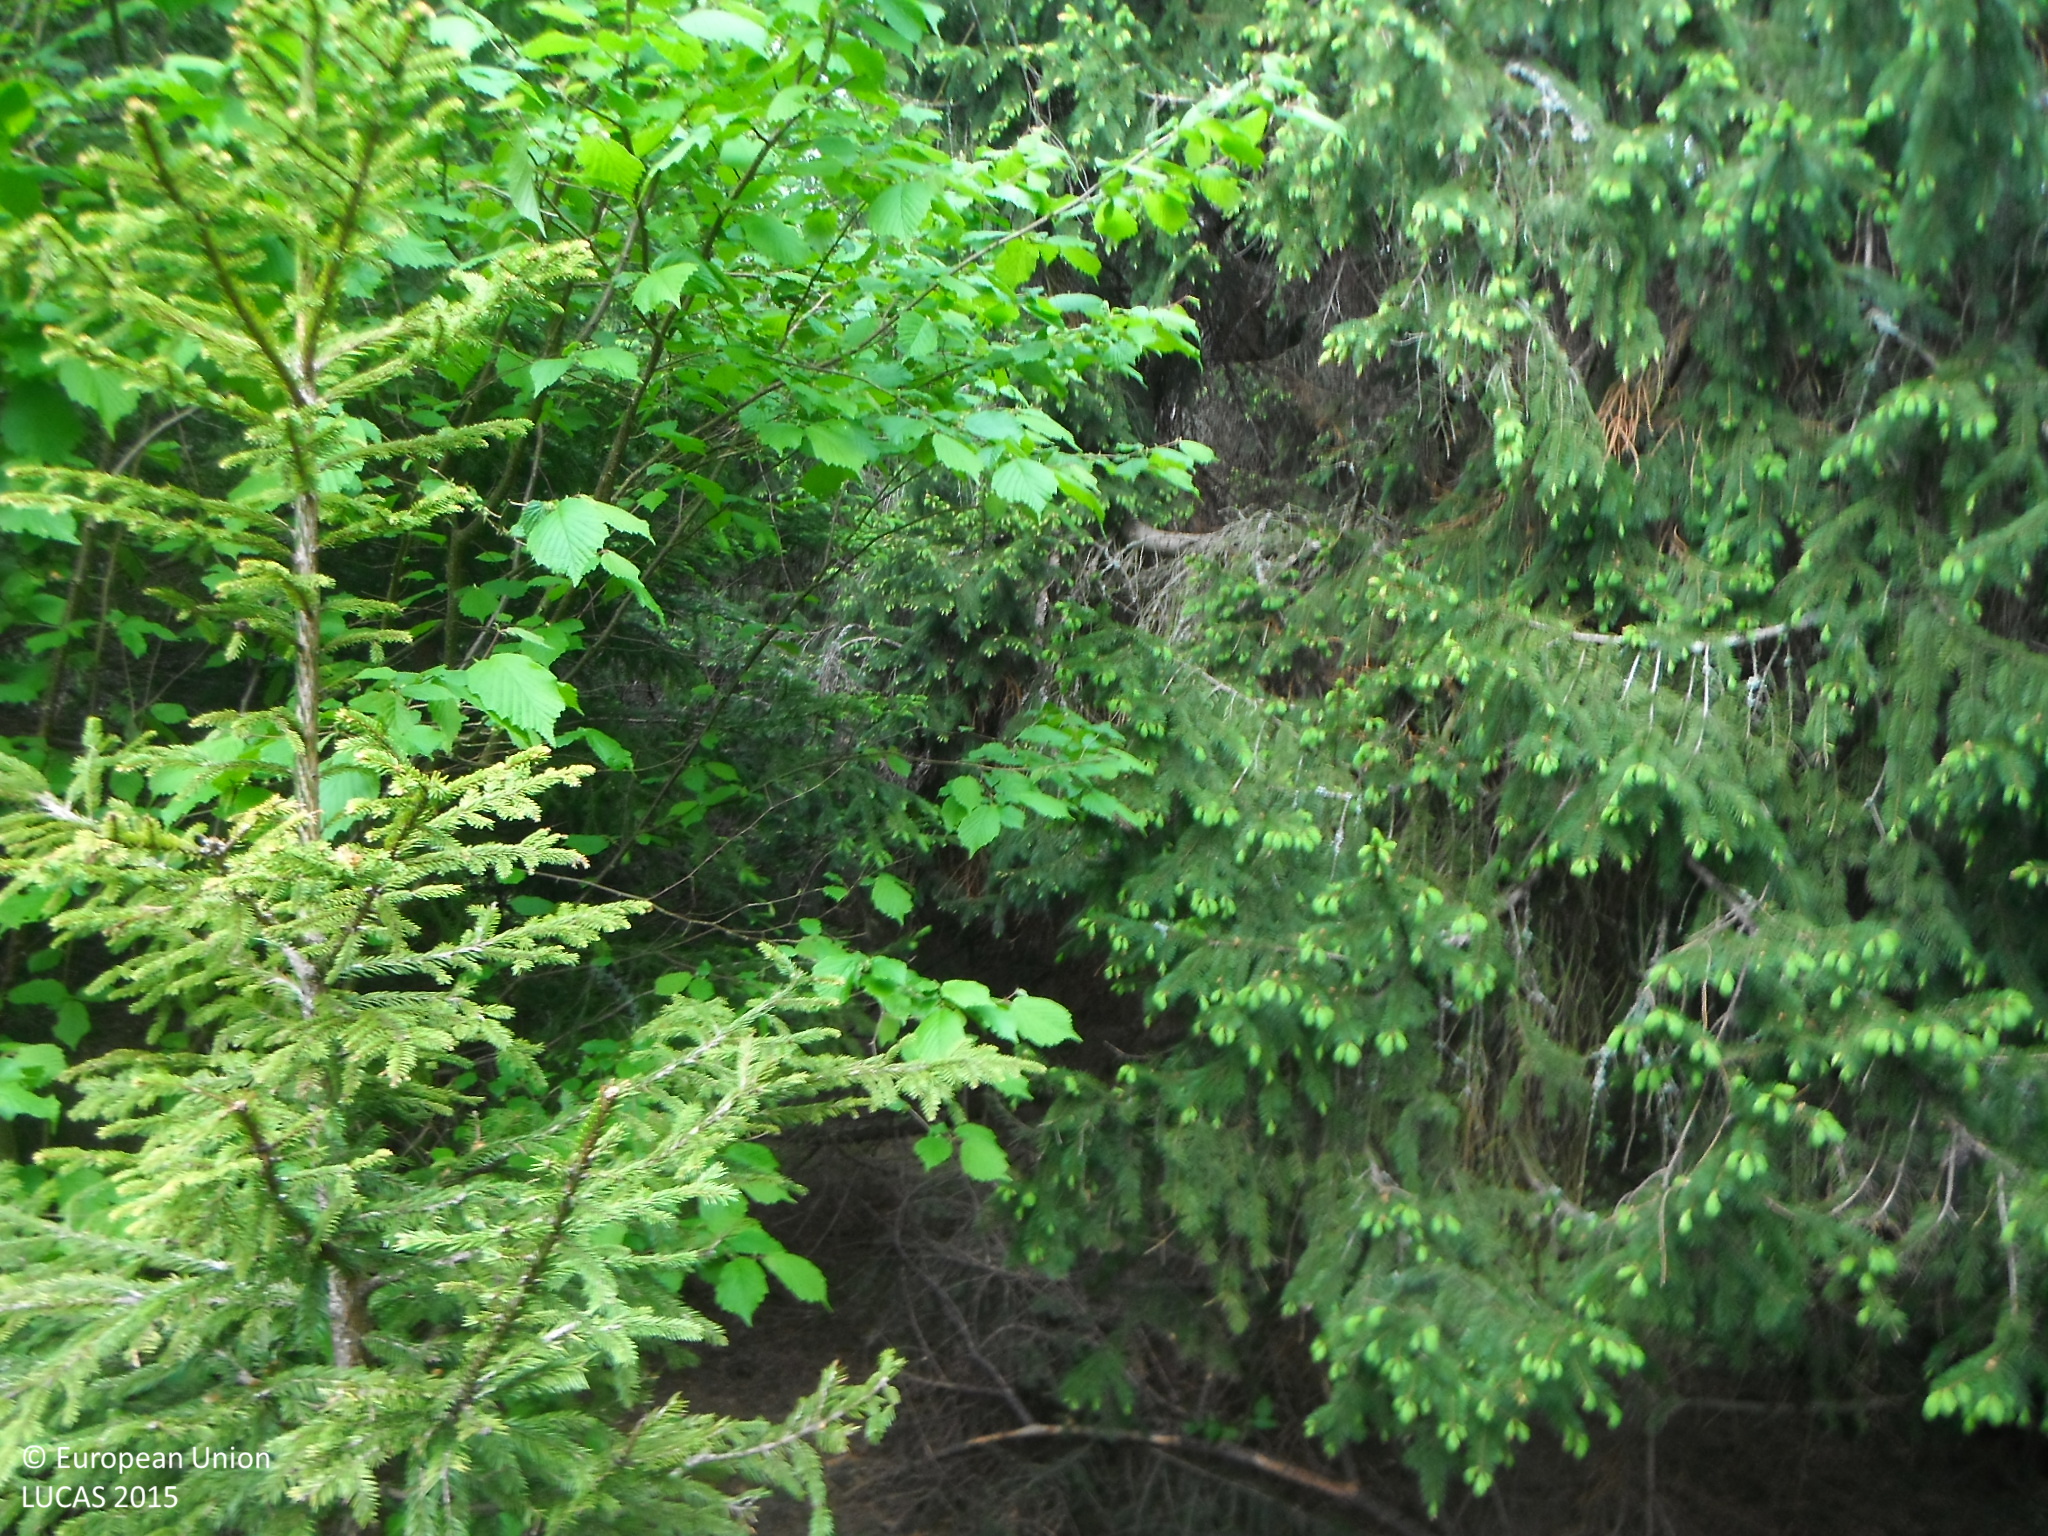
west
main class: Woodland
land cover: Other mixed woodland
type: hemiboreal forest and nemoral coniferous forest and mixed broadleaved-coniferous forest
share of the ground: > 75 %
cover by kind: broadleaved forest trees 60 %, coniferous forest trees 40 %
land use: Forestry
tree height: > 5 m
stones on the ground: 10 - 25 %
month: June
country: SK
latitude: 49.0952
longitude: 20.7348
